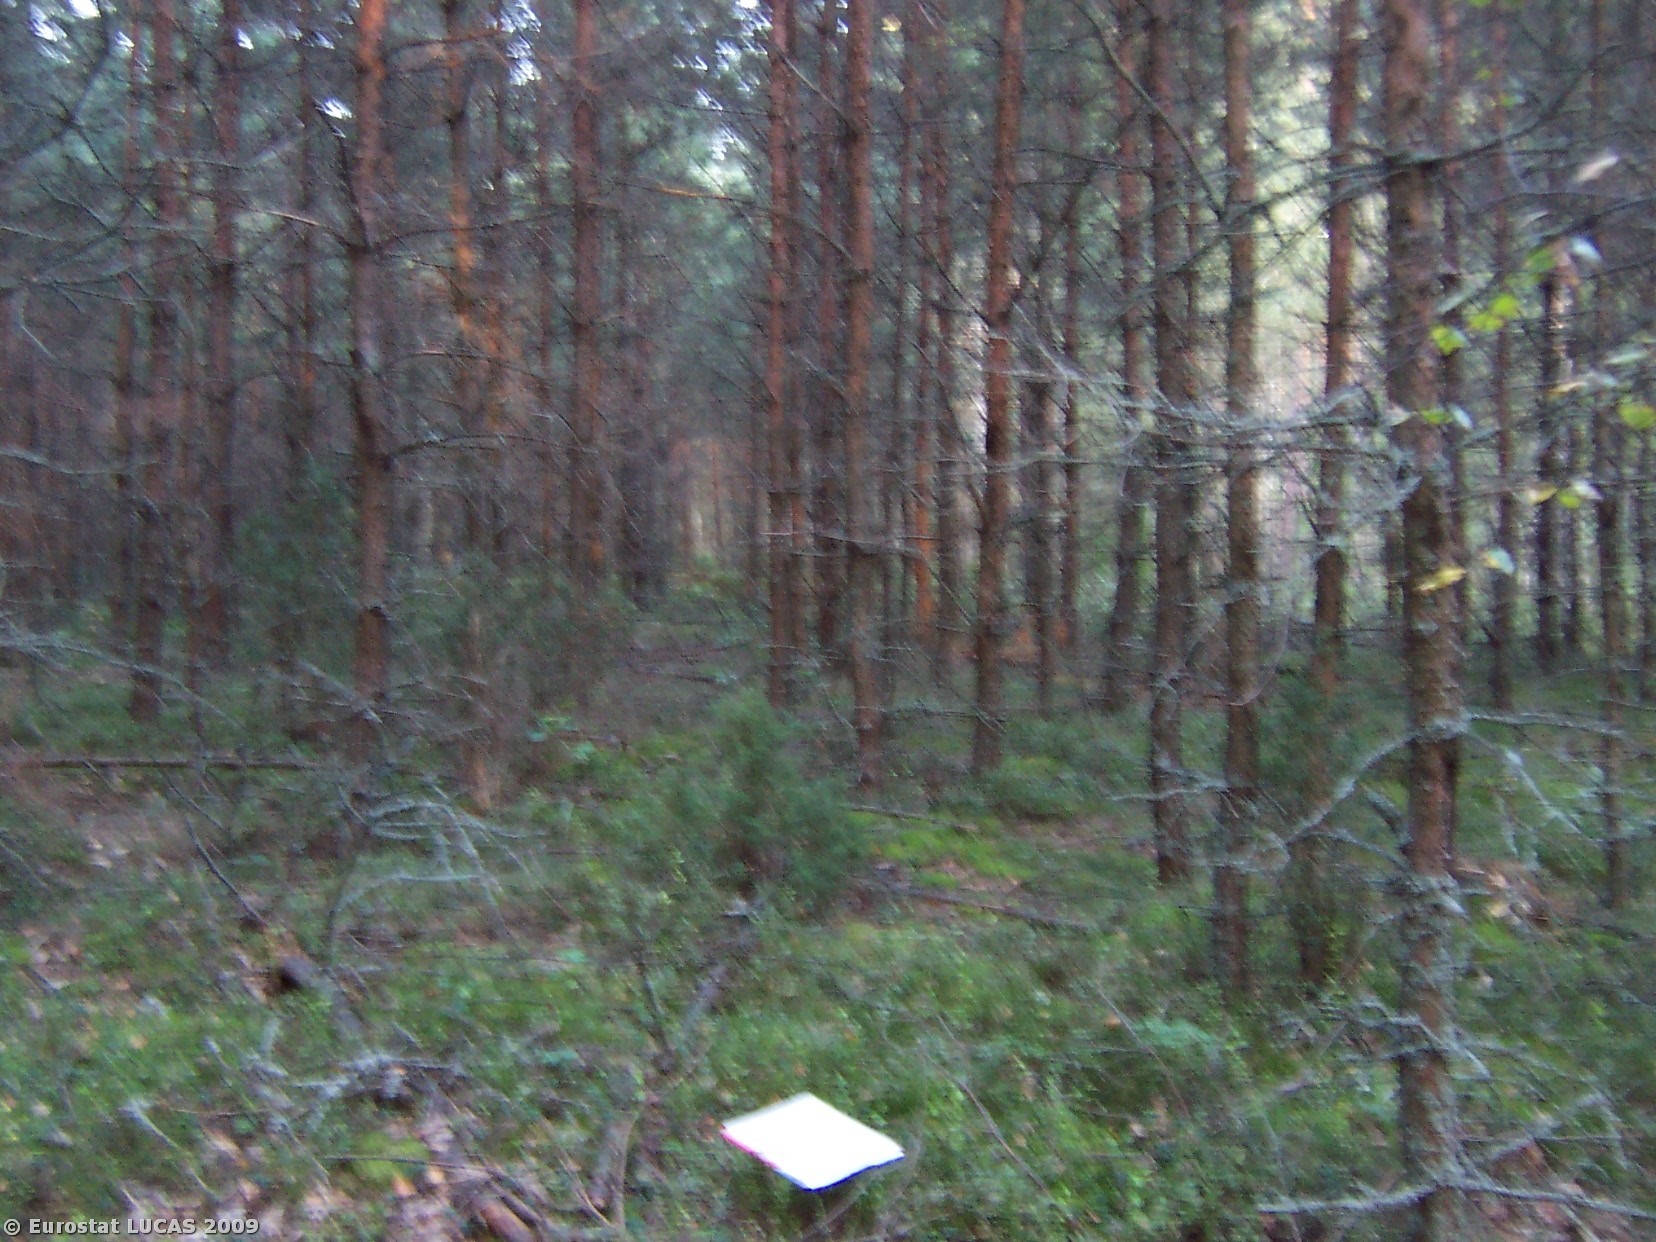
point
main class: Woodland
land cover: Mixed woodland
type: hemiboreal forest and nemoral coniferous forest and mixed broadleaved-coniferous forest
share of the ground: > 75 %
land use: Forestry
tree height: > 5 m
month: August
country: PL
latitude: 52.6994
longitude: 21.7597
